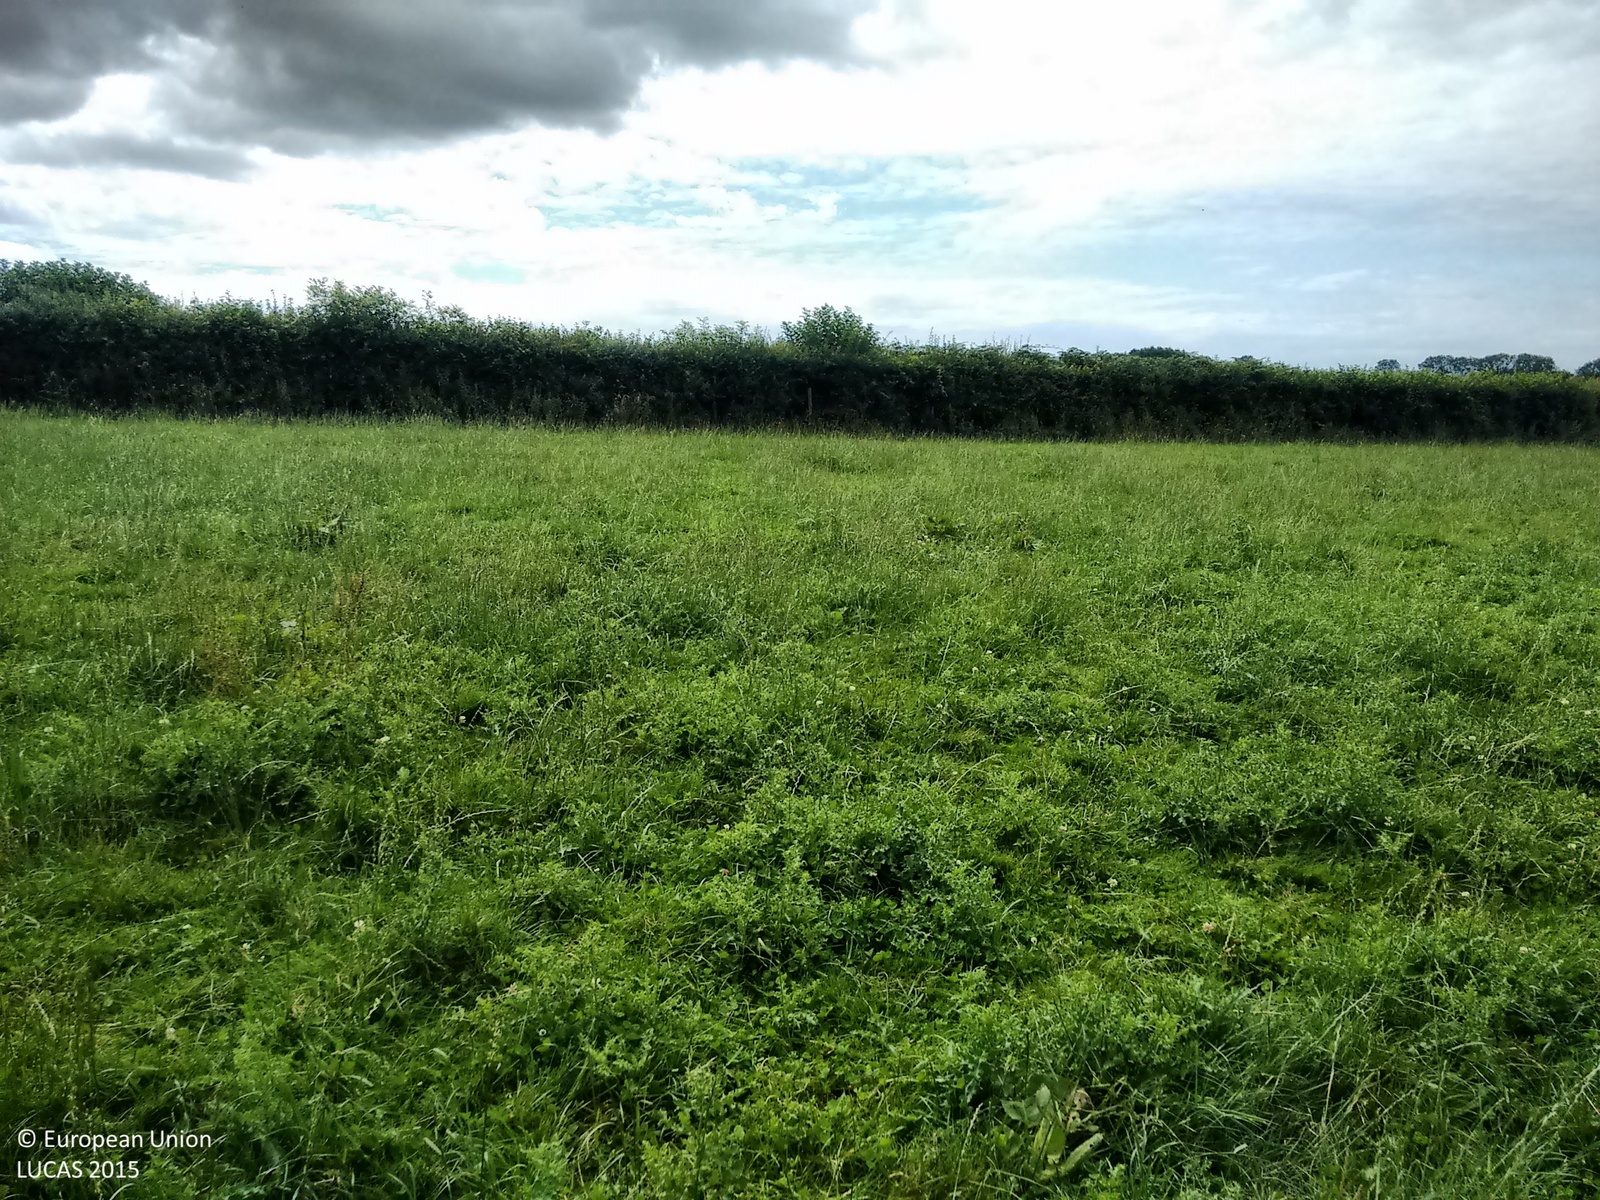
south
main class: Grassland
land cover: Grassland without tree/shrub cover
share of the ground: > 75 %
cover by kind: herbaceous plants 100 %
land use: Agriculture (excluding fallow land and kitchen gardens)
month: August
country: GB
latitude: 50.3983
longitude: -3.9495
